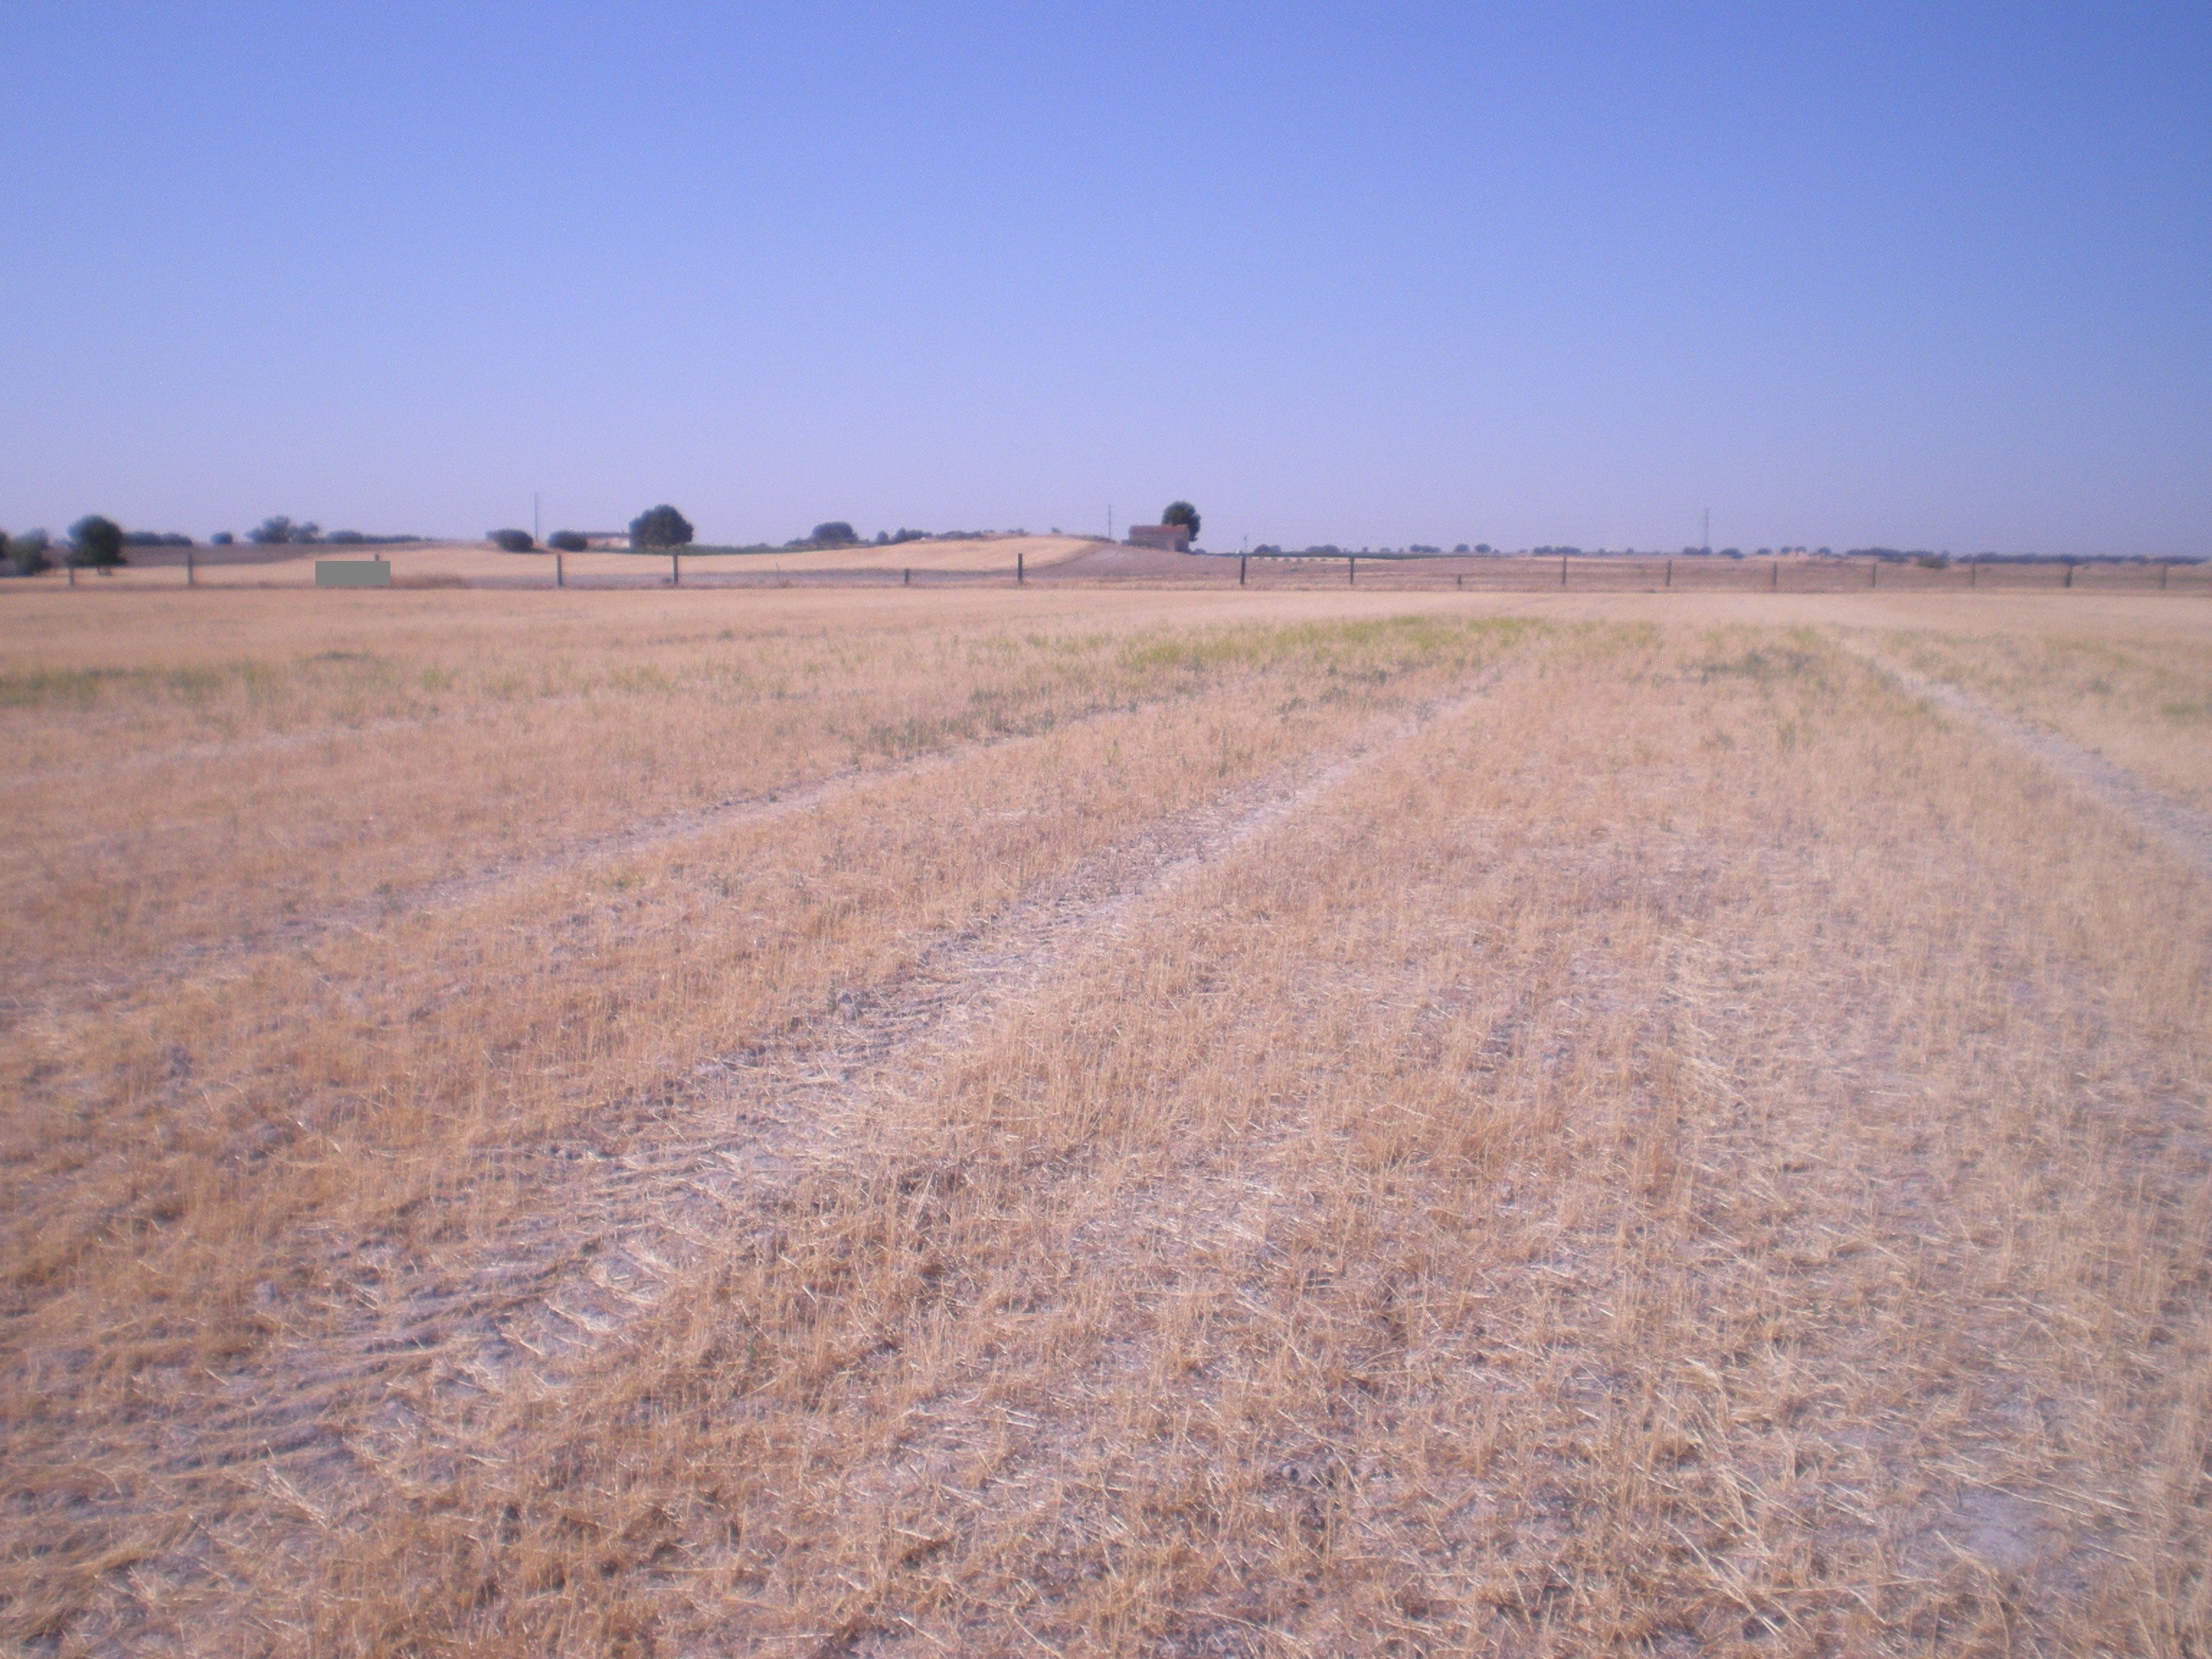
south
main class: Cropland
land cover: Barley
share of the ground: < 10 %
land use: Agriculture (excluding fallow land and kitchen gardens)
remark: Harvested field
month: July
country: ES
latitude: 39.2884
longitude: -3.2689
